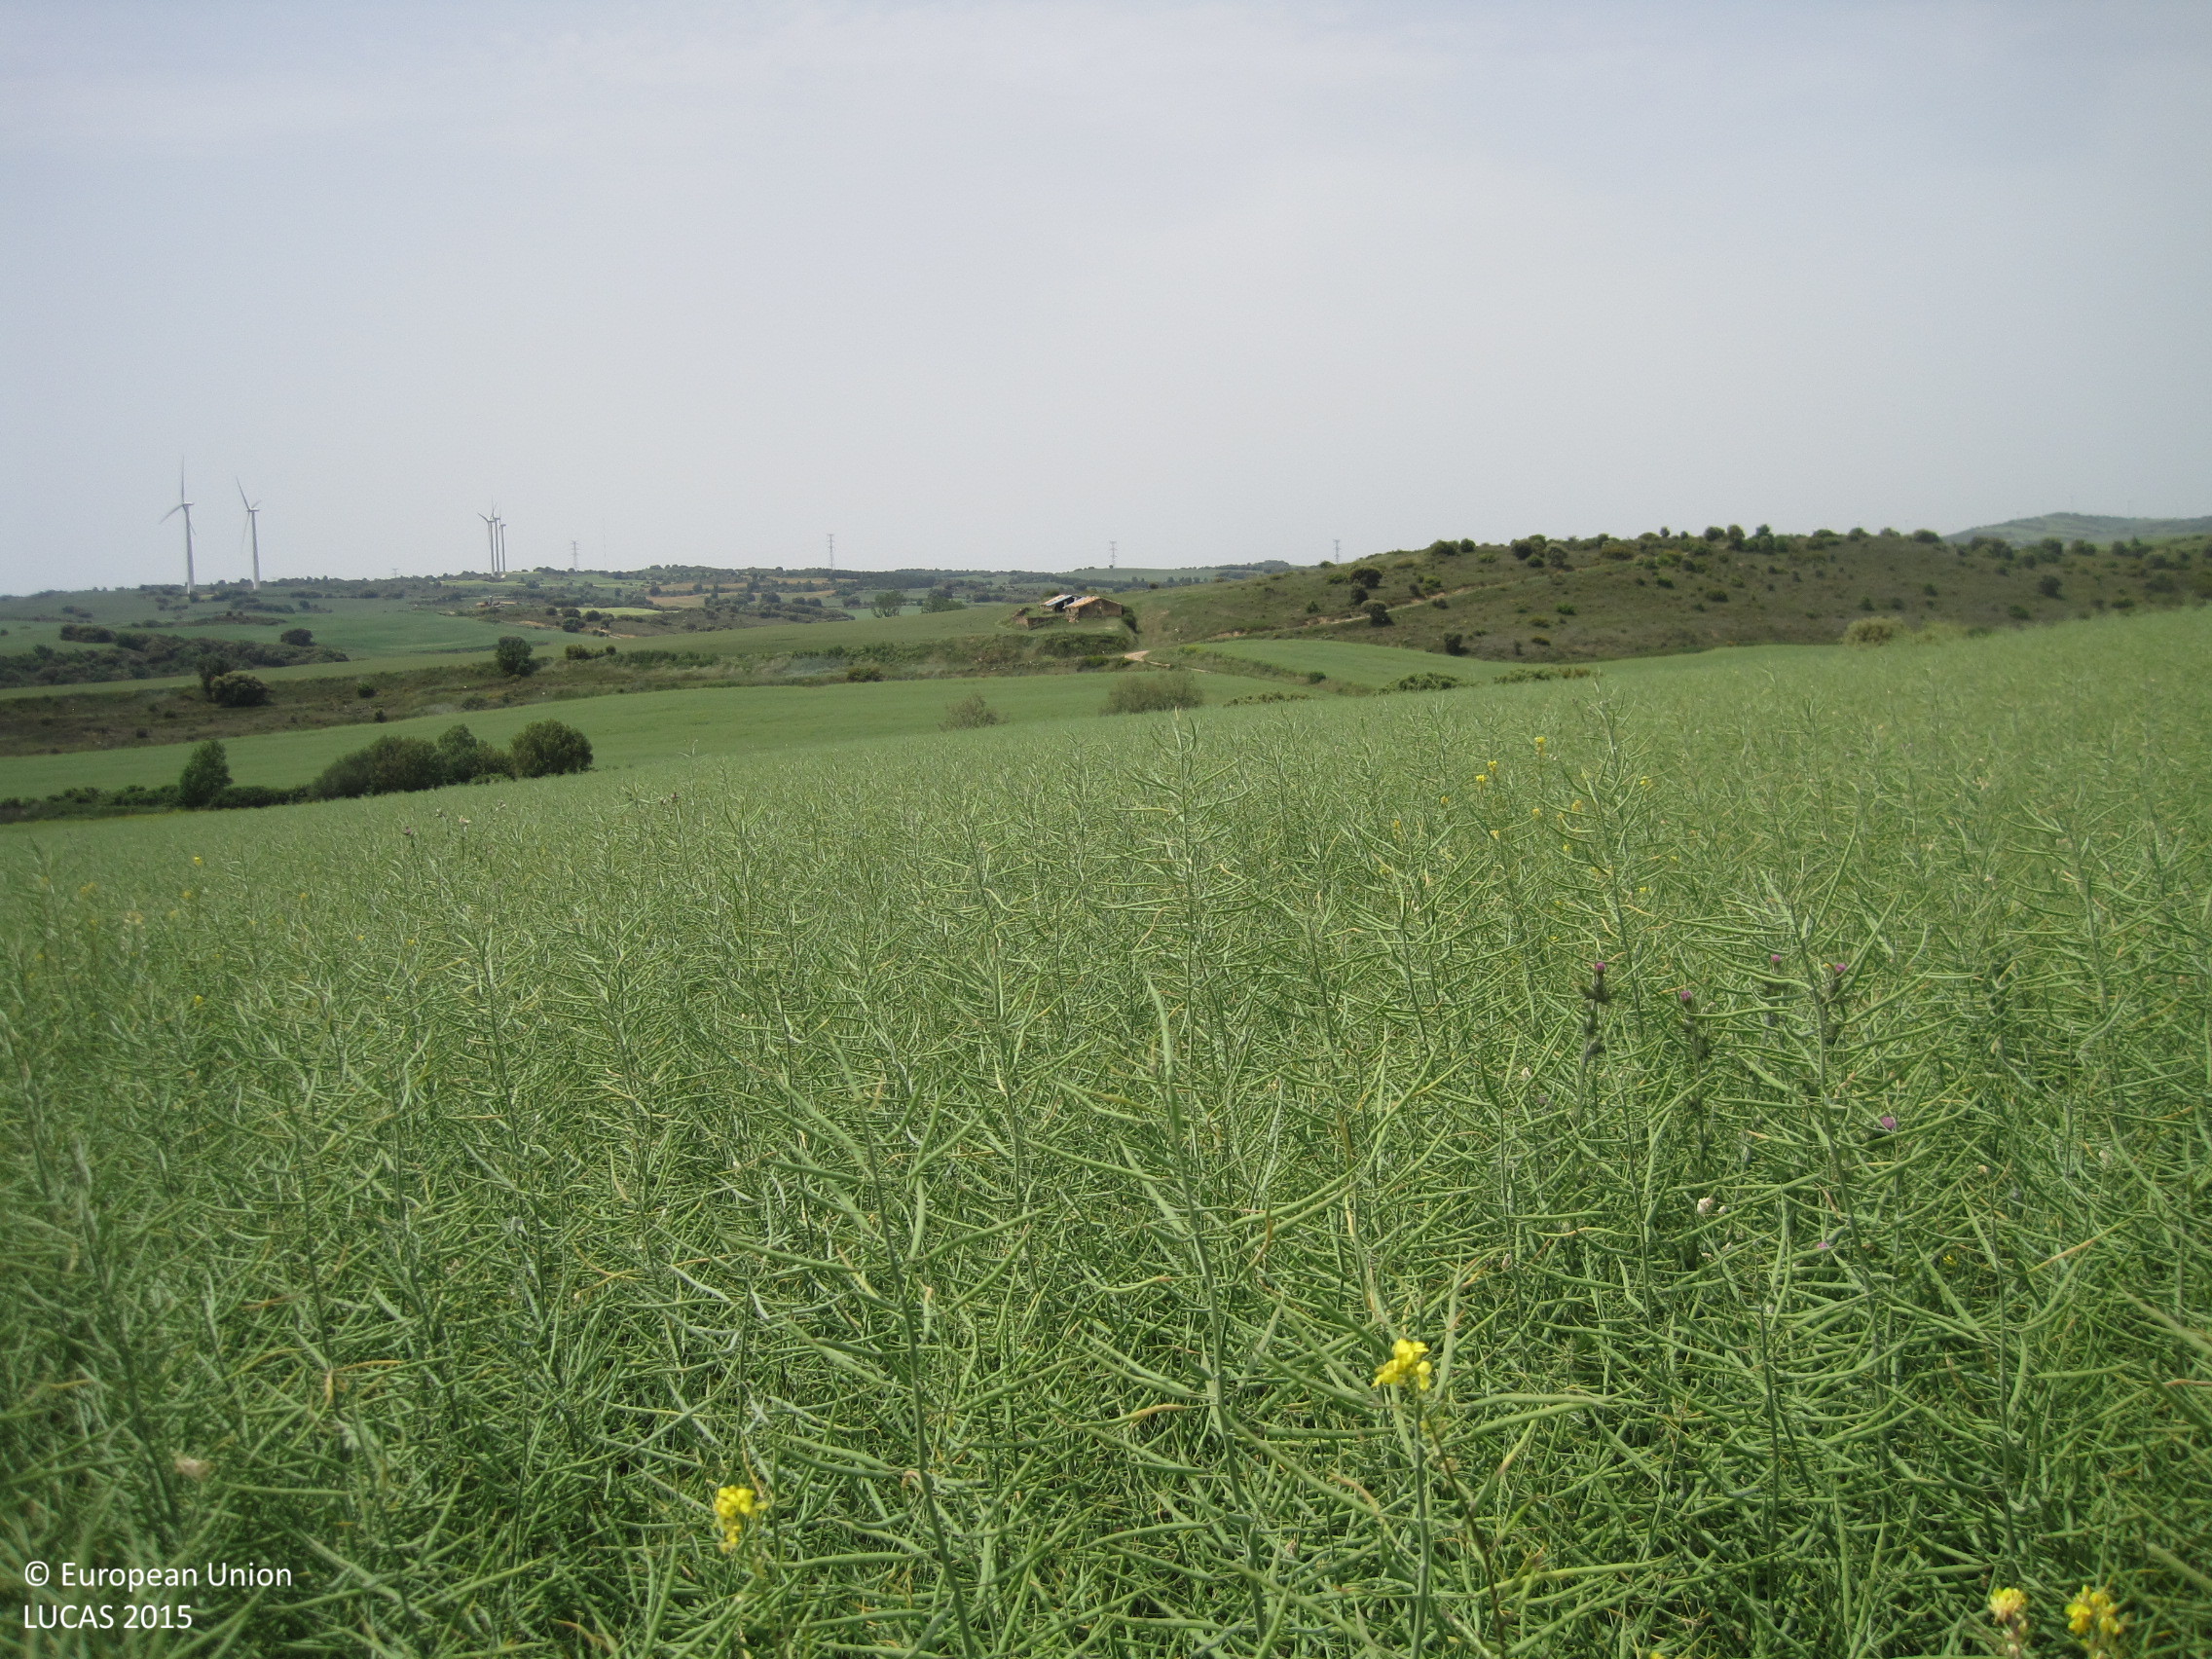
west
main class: Cropland
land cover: Rape and turnip rape
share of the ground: > 75 %
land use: Agriculture (excluding fallow land and kitchen gardens)
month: May
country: ES
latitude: 42.6166
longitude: -1.6557
